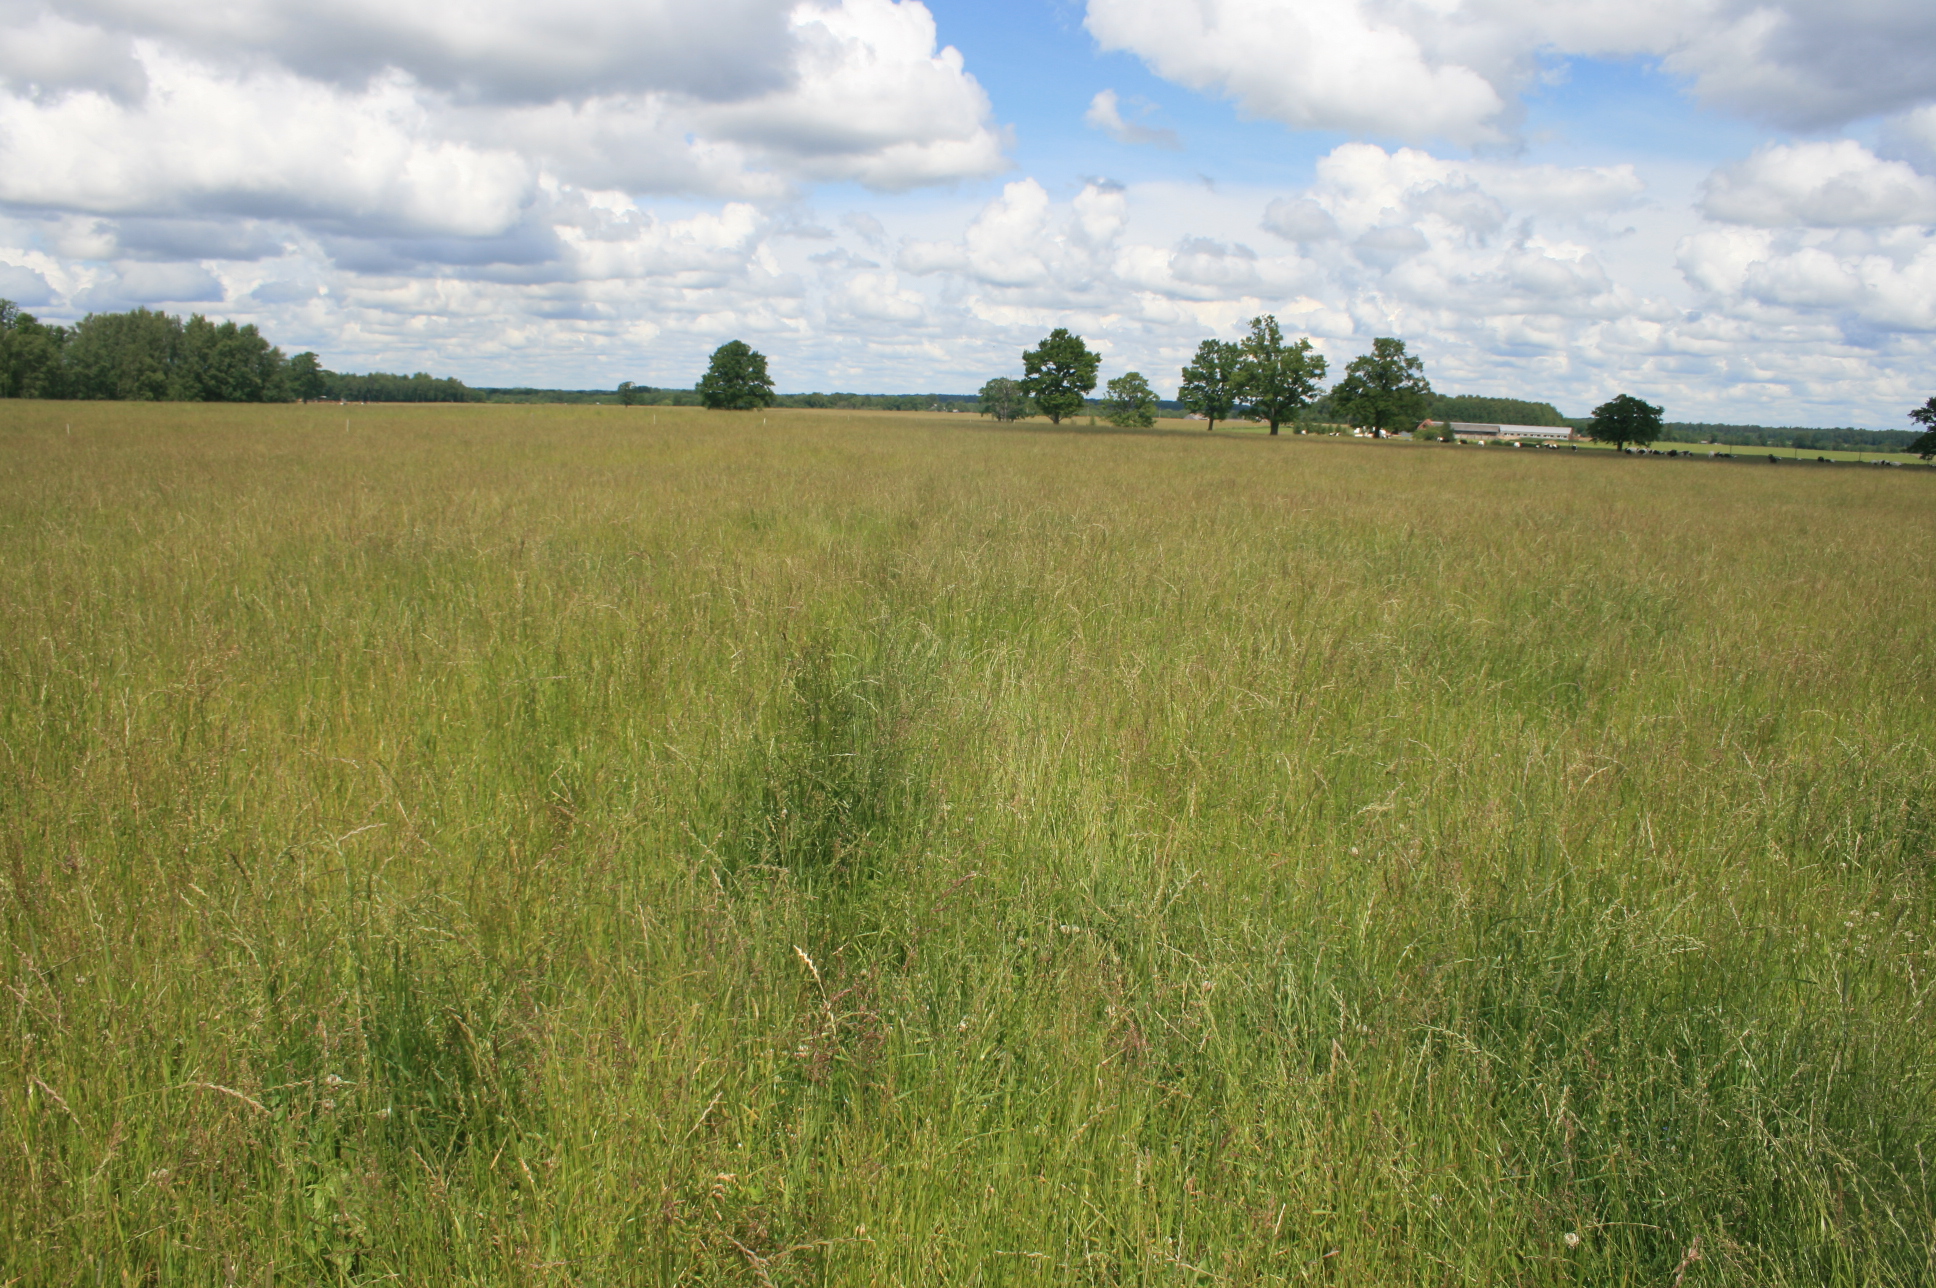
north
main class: Grassland
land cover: Grassland without tree/shrub cover
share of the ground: > 75 %
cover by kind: herbaceous plants 100 %
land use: Agriculture (excluding fallow land and kitchen gardens)
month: June
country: LT
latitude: 55.2703
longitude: 22.0637
